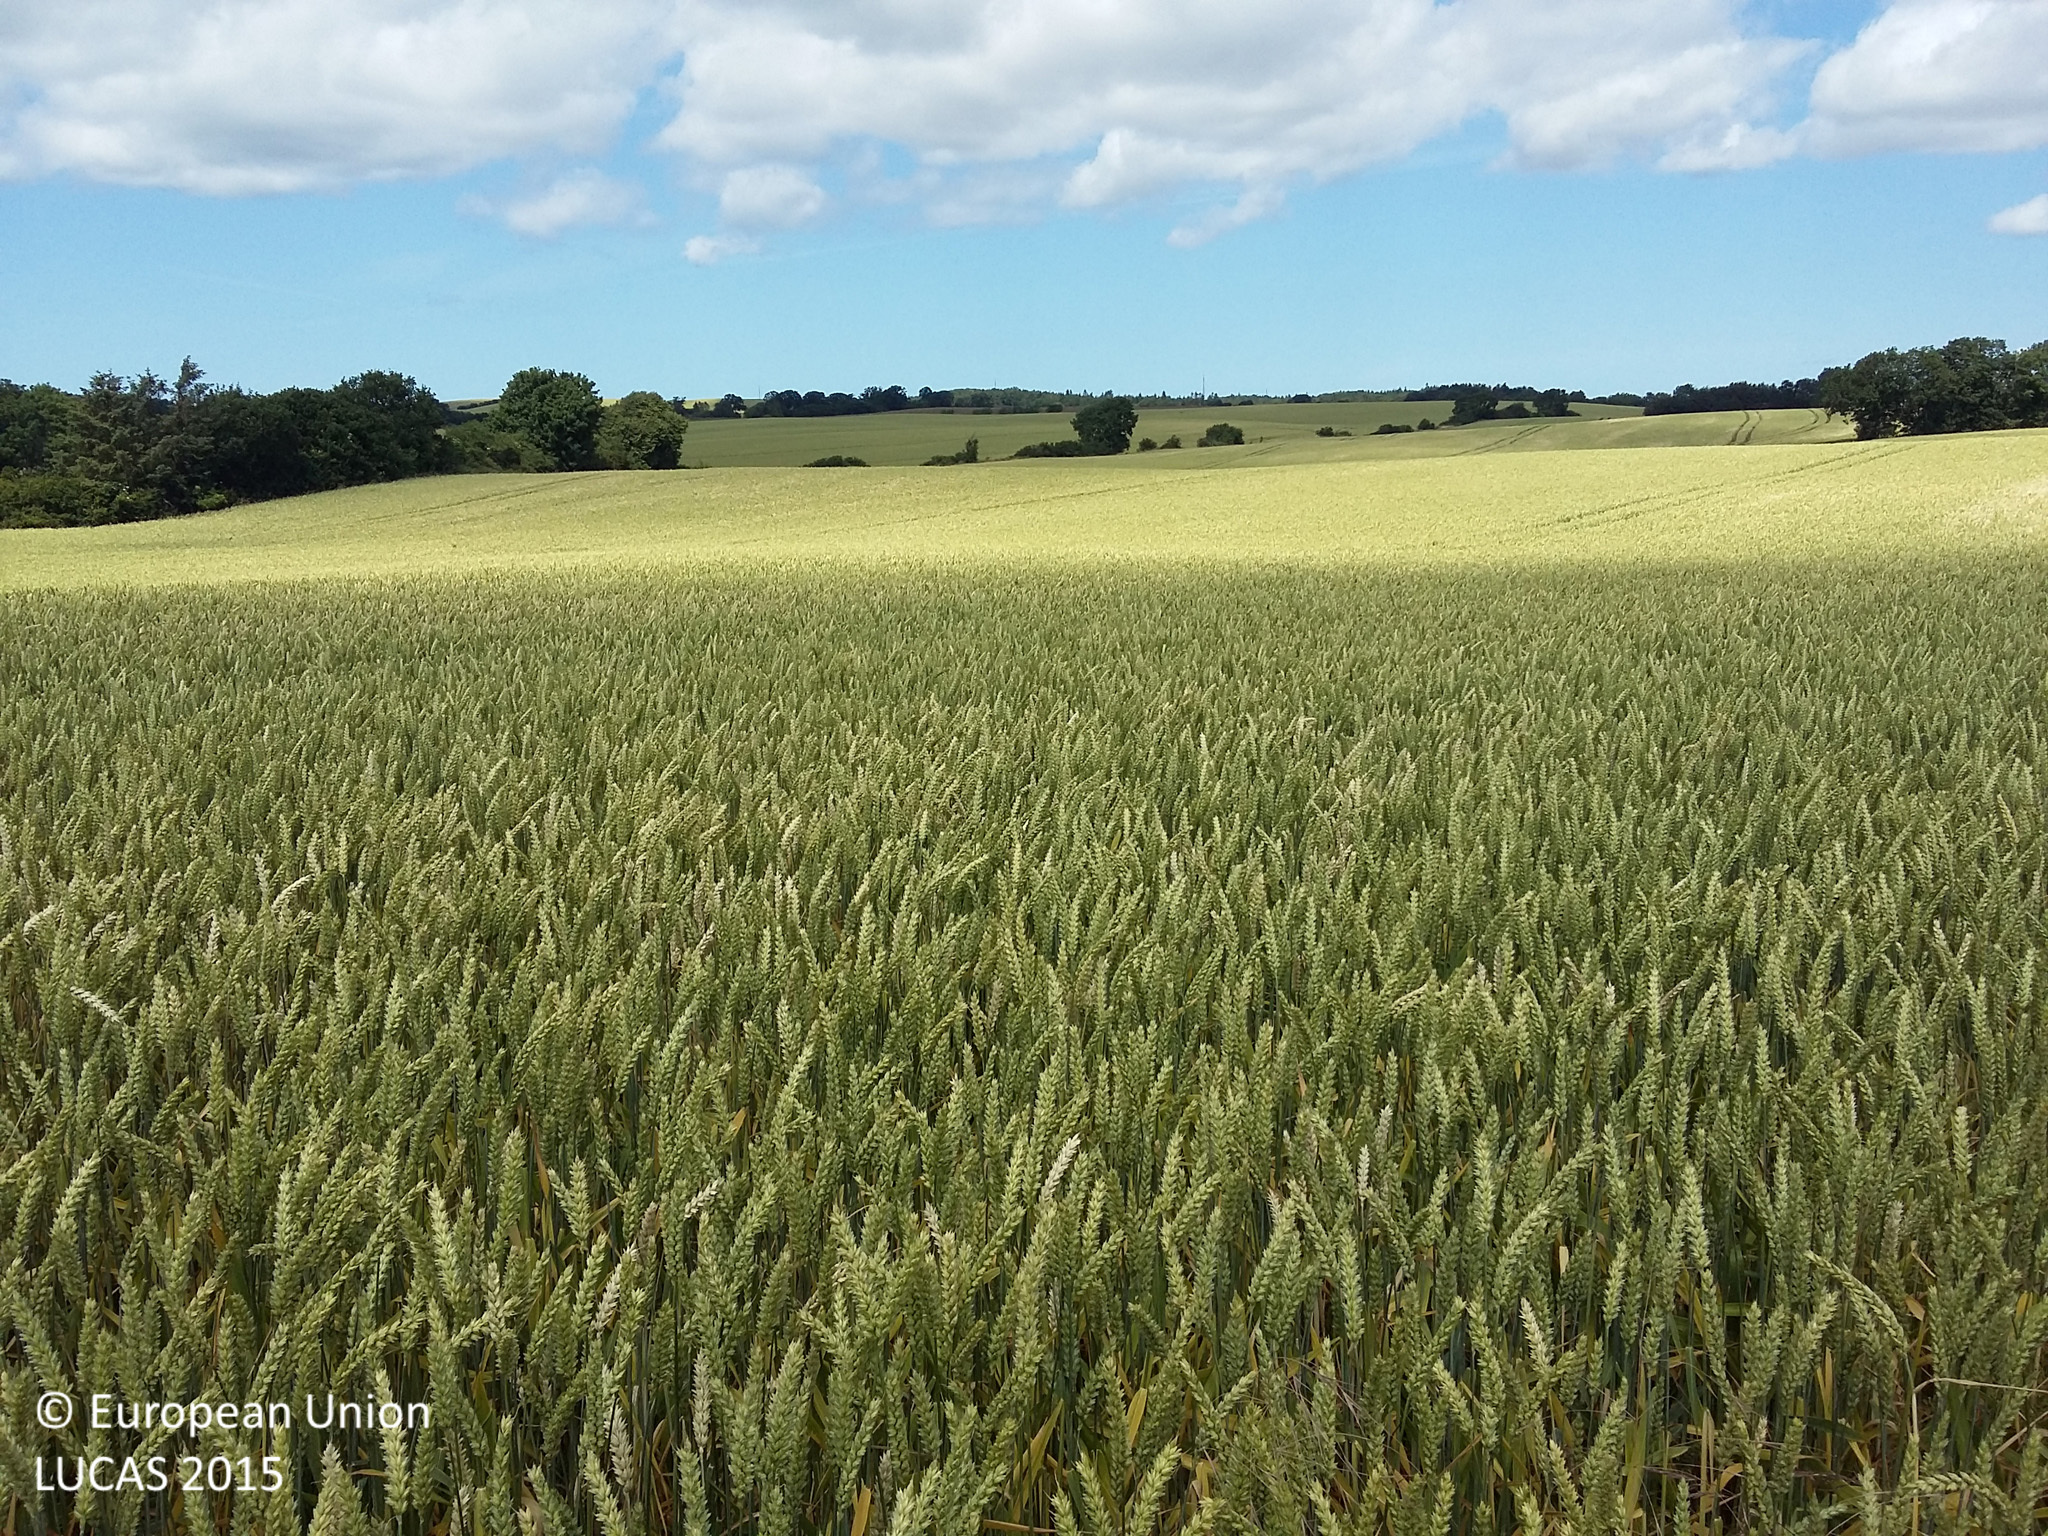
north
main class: Cropland
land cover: Common wheat
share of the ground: > 75 %
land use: Agriculture (excluding fallow land and kitchen gardens)
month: July
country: DK
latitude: 55.6240
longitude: 11.2851
